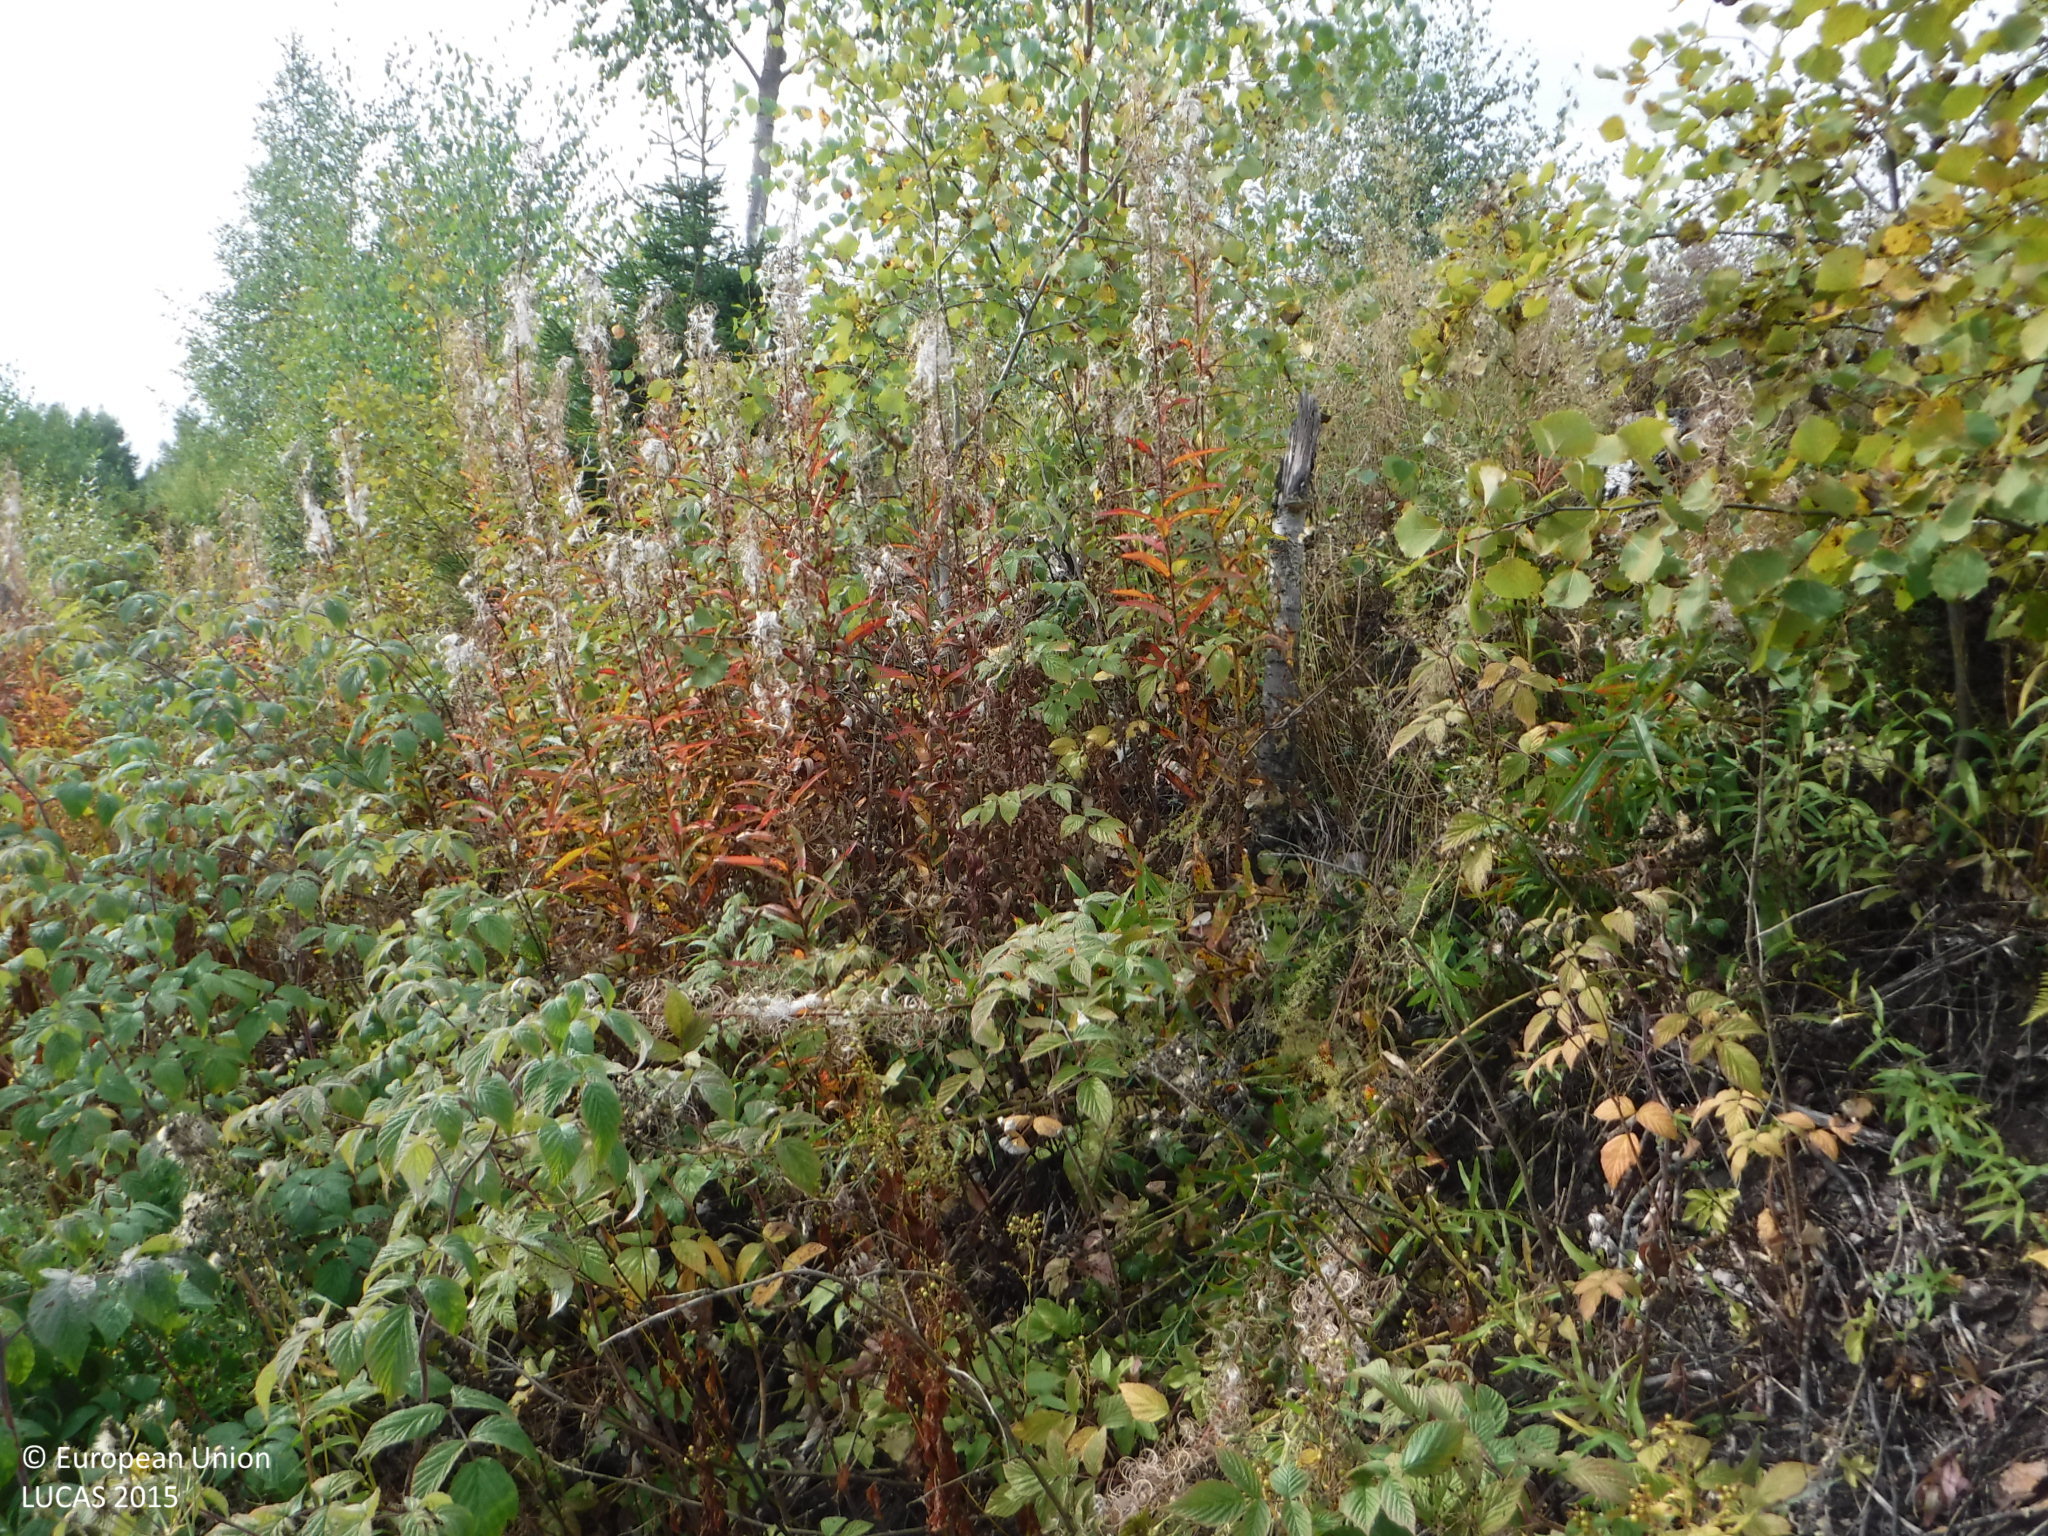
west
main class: Woodland
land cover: Broadleaved woodland
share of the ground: > 75 %
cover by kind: broadleaved forest trees 75 %, shrubs 20 %, herbaceous plants 5 %
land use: Semi-natural and natural areas not in use
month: September
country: FI
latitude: 61.4213
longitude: 23.0209
